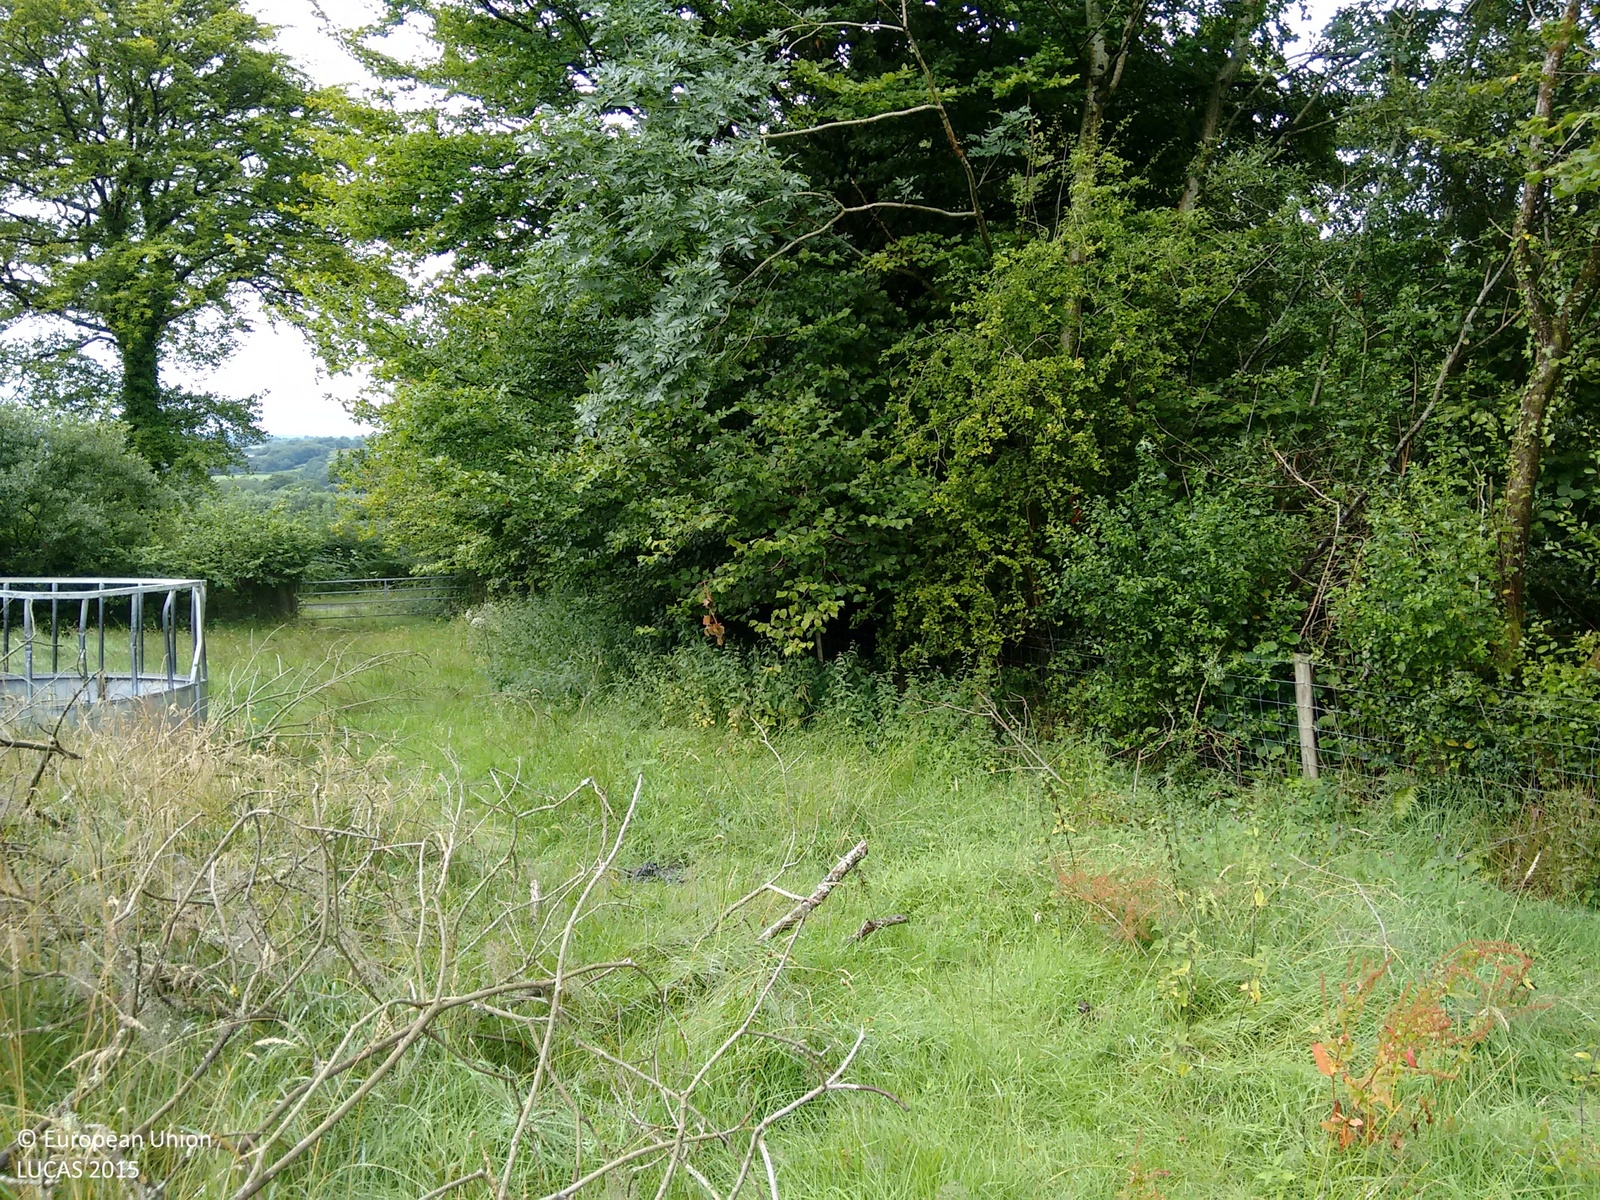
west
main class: Grassland
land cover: Grassland without tree/shrub cover
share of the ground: > 75 %
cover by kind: herbaceous plants 100 %
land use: Agriculture (excluding fallow land and kitchen gardens)
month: August
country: GB
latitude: 51.9175
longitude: -4.0681
